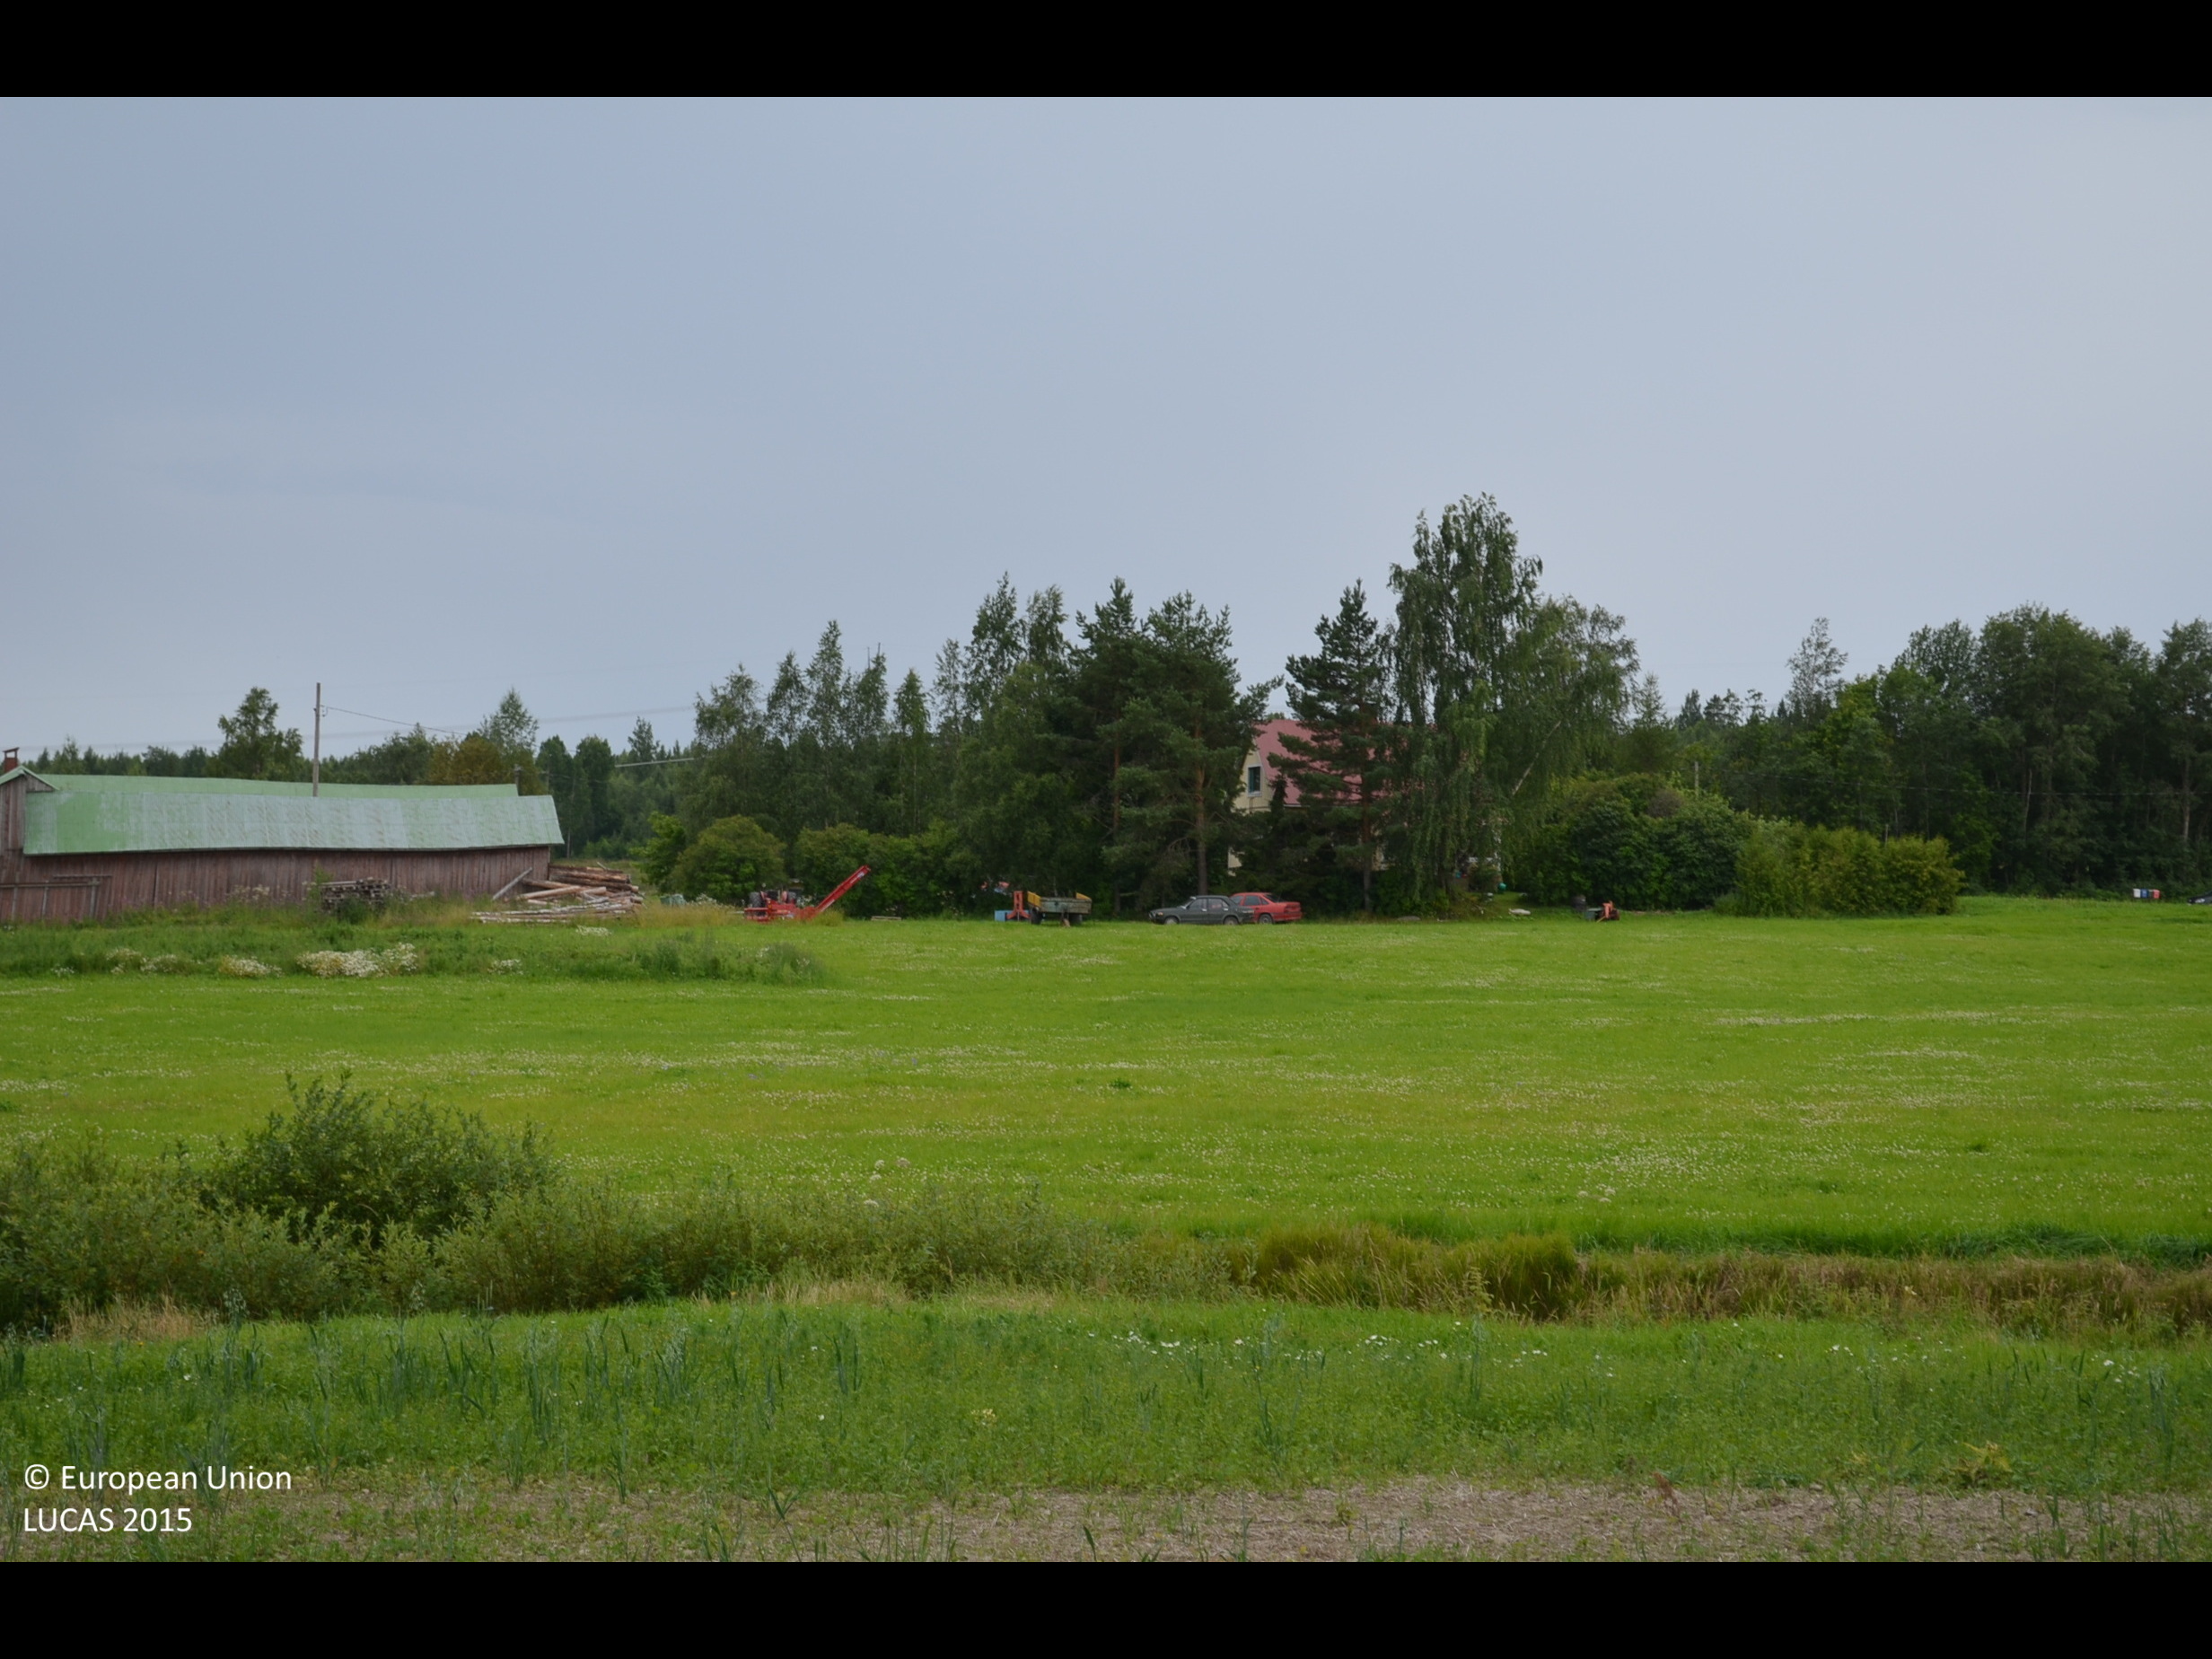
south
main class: Cropland
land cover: Common wheat
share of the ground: > 75 %
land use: Agriculture (excluding fallow land and kitchen gardens)
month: August
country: FI
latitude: 61.4929
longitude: 23.2415
